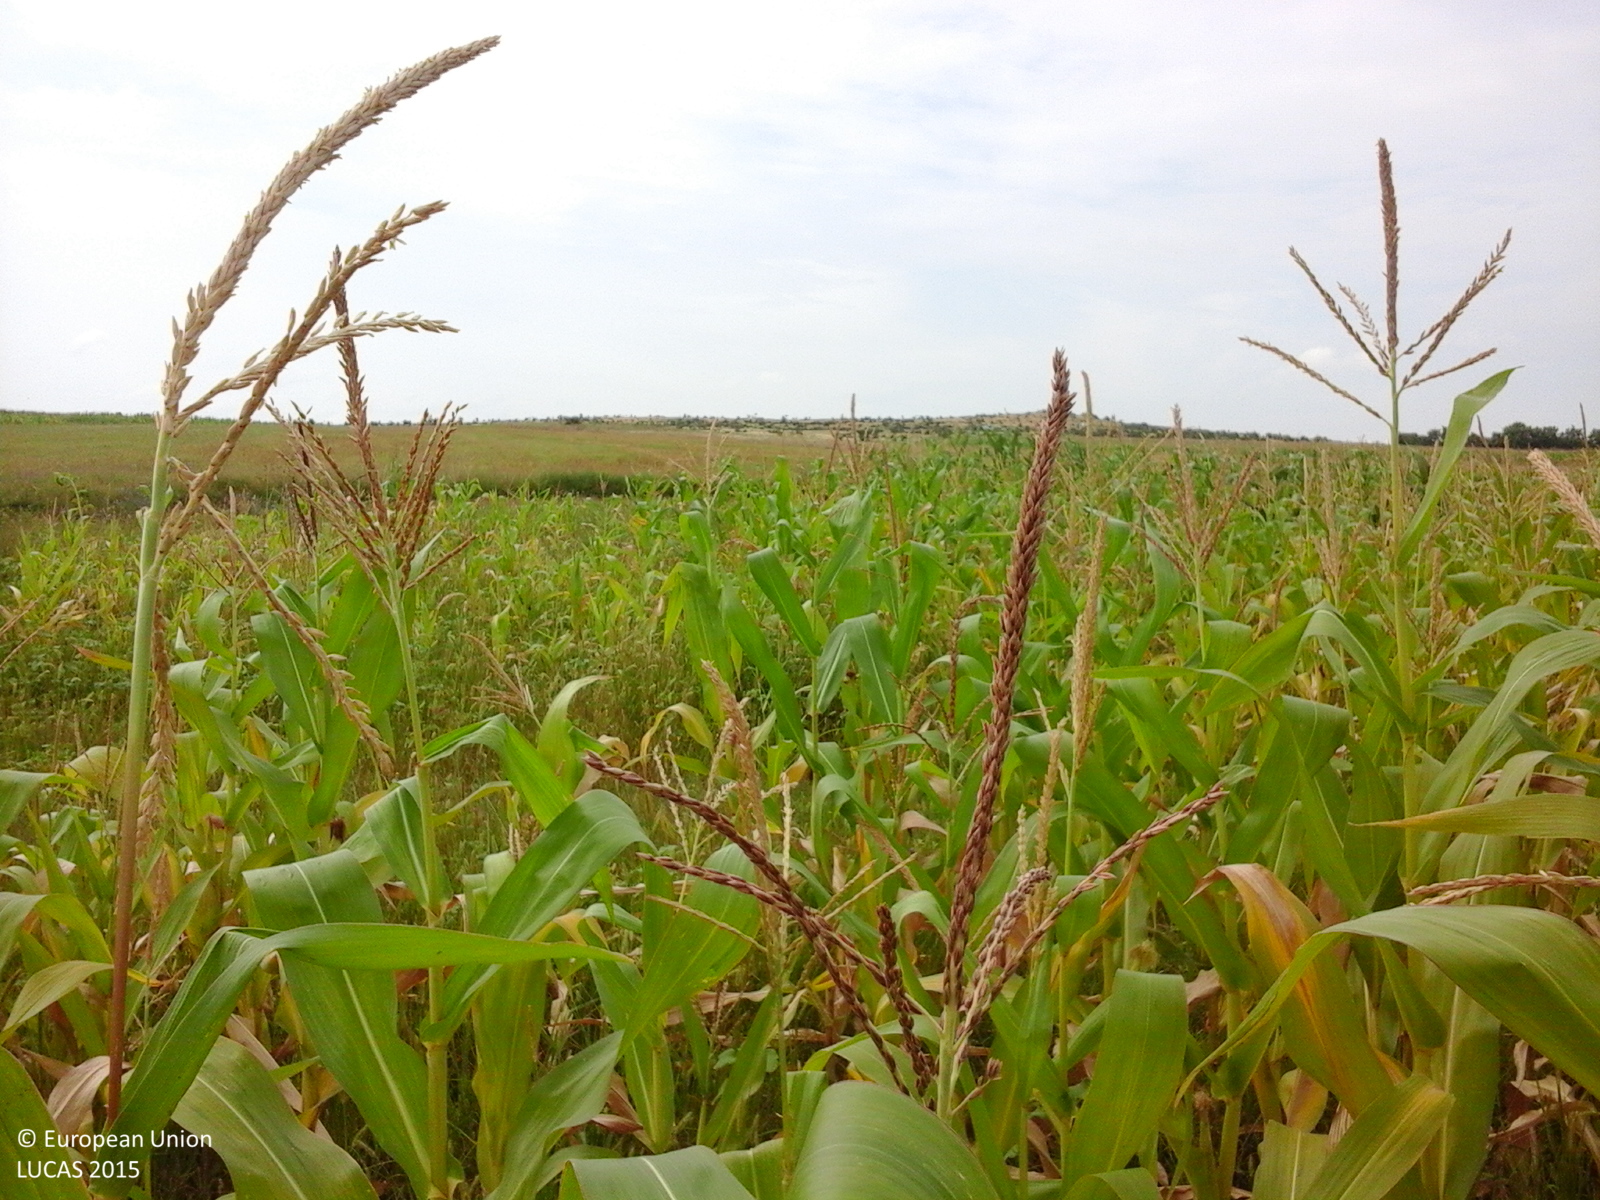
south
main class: Cropland
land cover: Maize
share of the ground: > 75 %
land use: Agriculture (excluding fallow land and kitchen gardens)
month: August
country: RO
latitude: 44.7374
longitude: 28.5003
